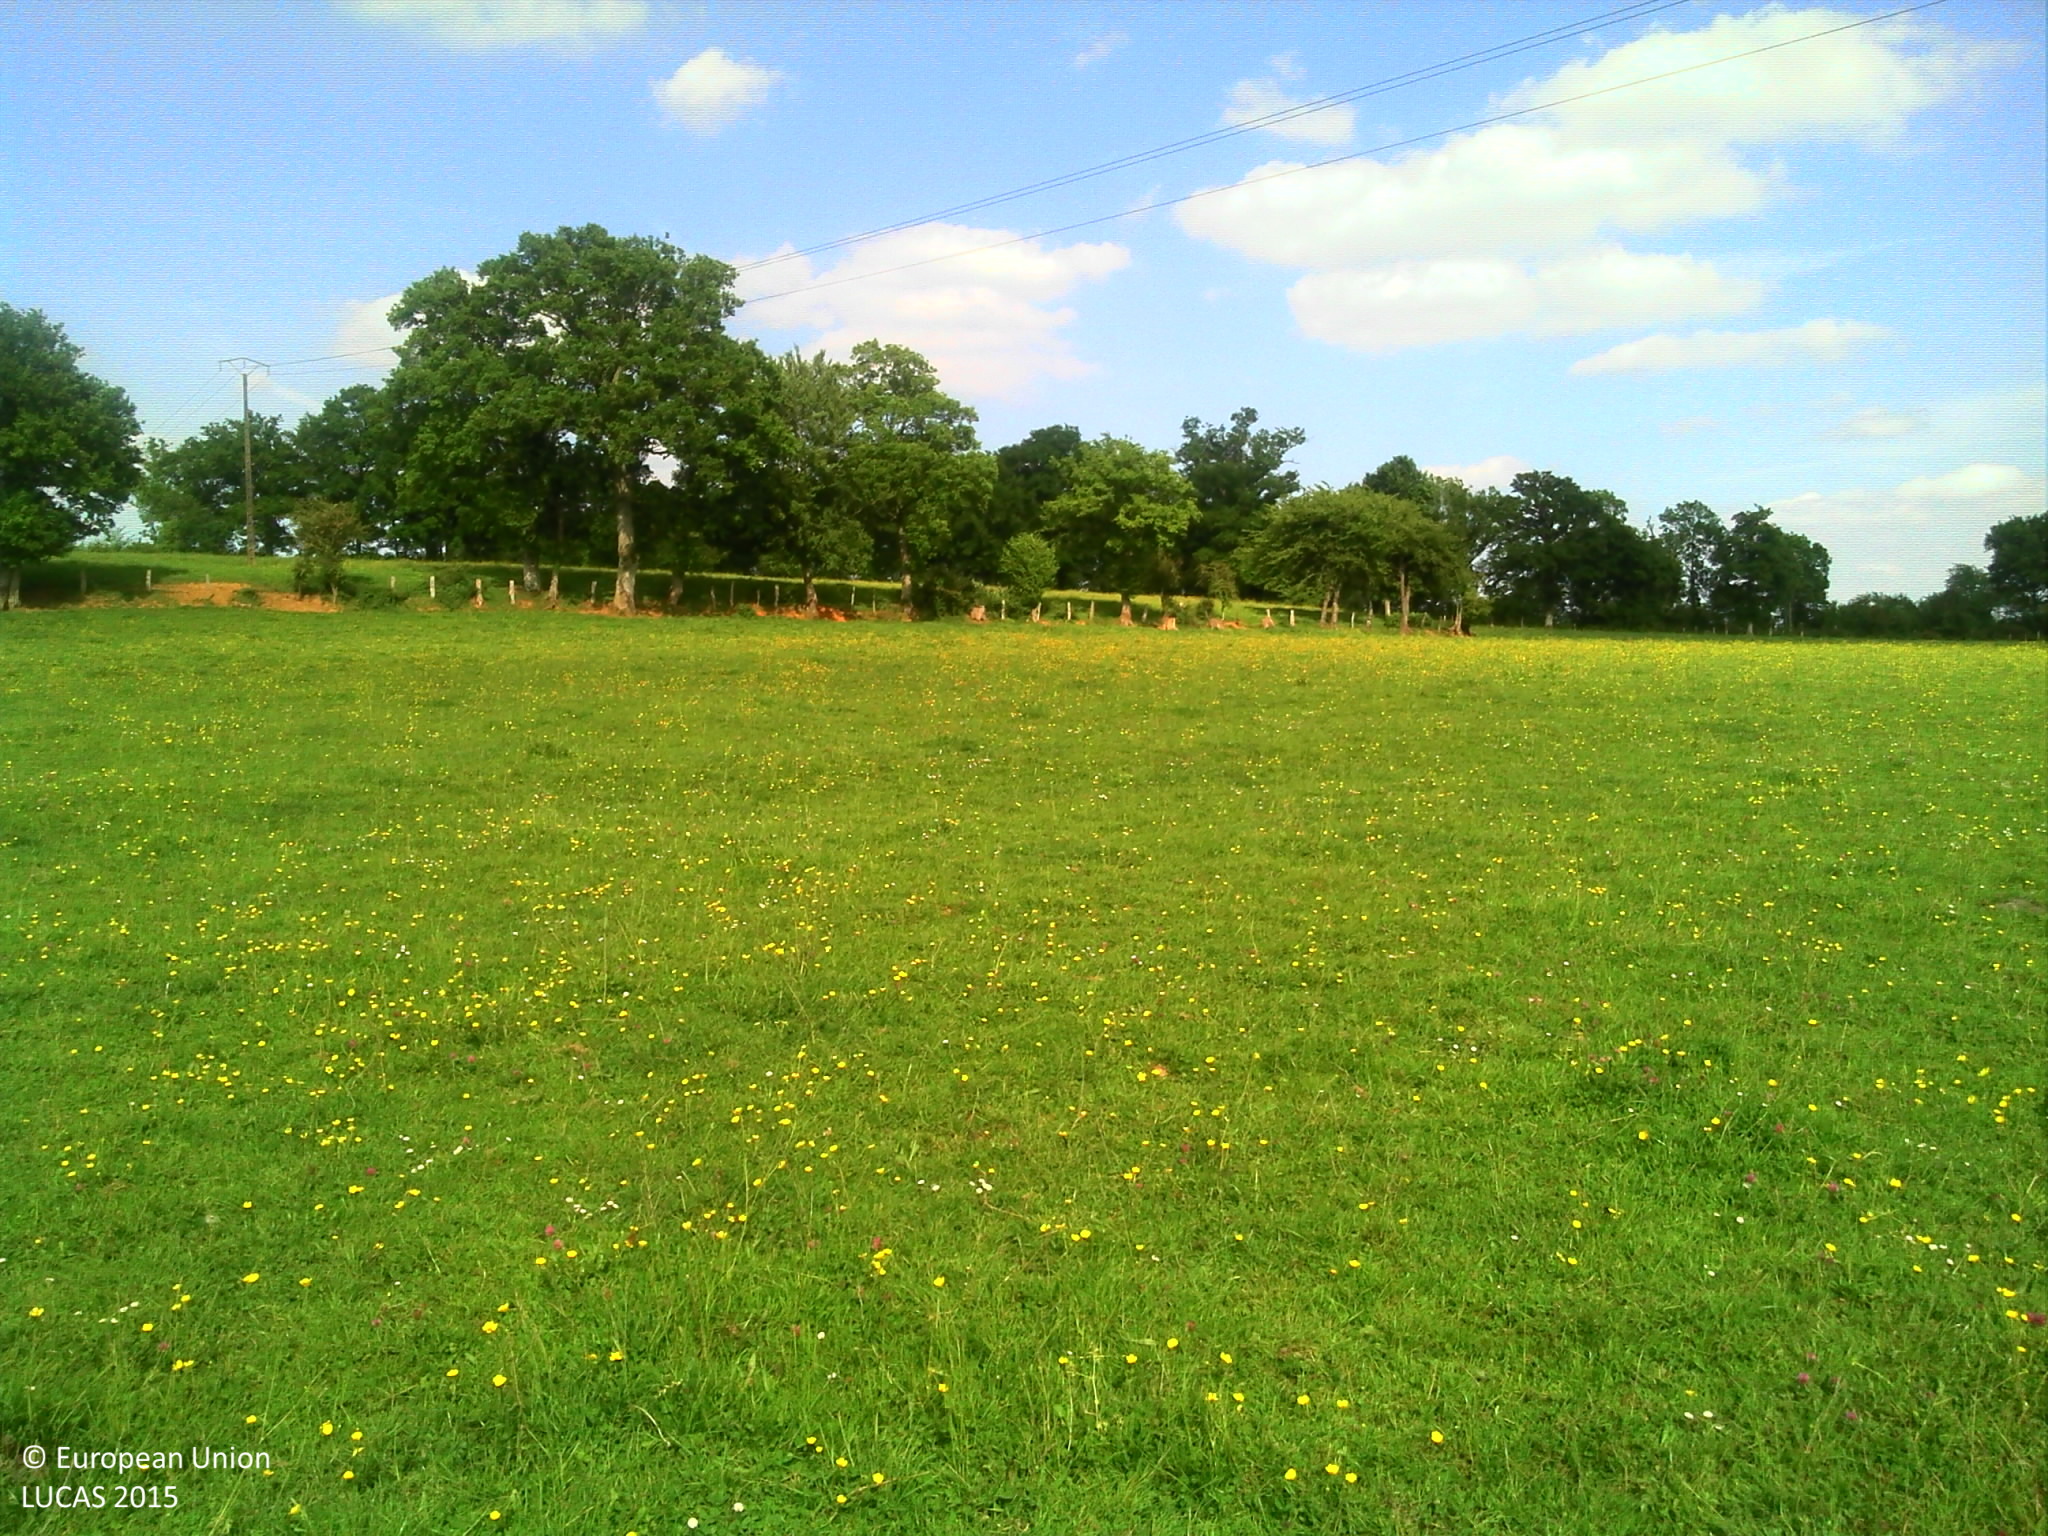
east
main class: Grassland
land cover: Grassland without tree/shrub cover
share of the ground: > 75 %
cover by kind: herbaceous plants 95 %, shrubs 5 %
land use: Agriculture (excluding fallow land and kitchen gardens)
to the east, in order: Grassland without tree/shrub cover; Fences; Lines of trees; Grassland without tree/shrub cover; Electric lines; Grassland without tree/shrub cover; Fences; Lines of trees; Tracks; Lines of trees; Grassland without tree/shrub cover
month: May
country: FR
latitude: 48.6940
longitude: -0.1804
